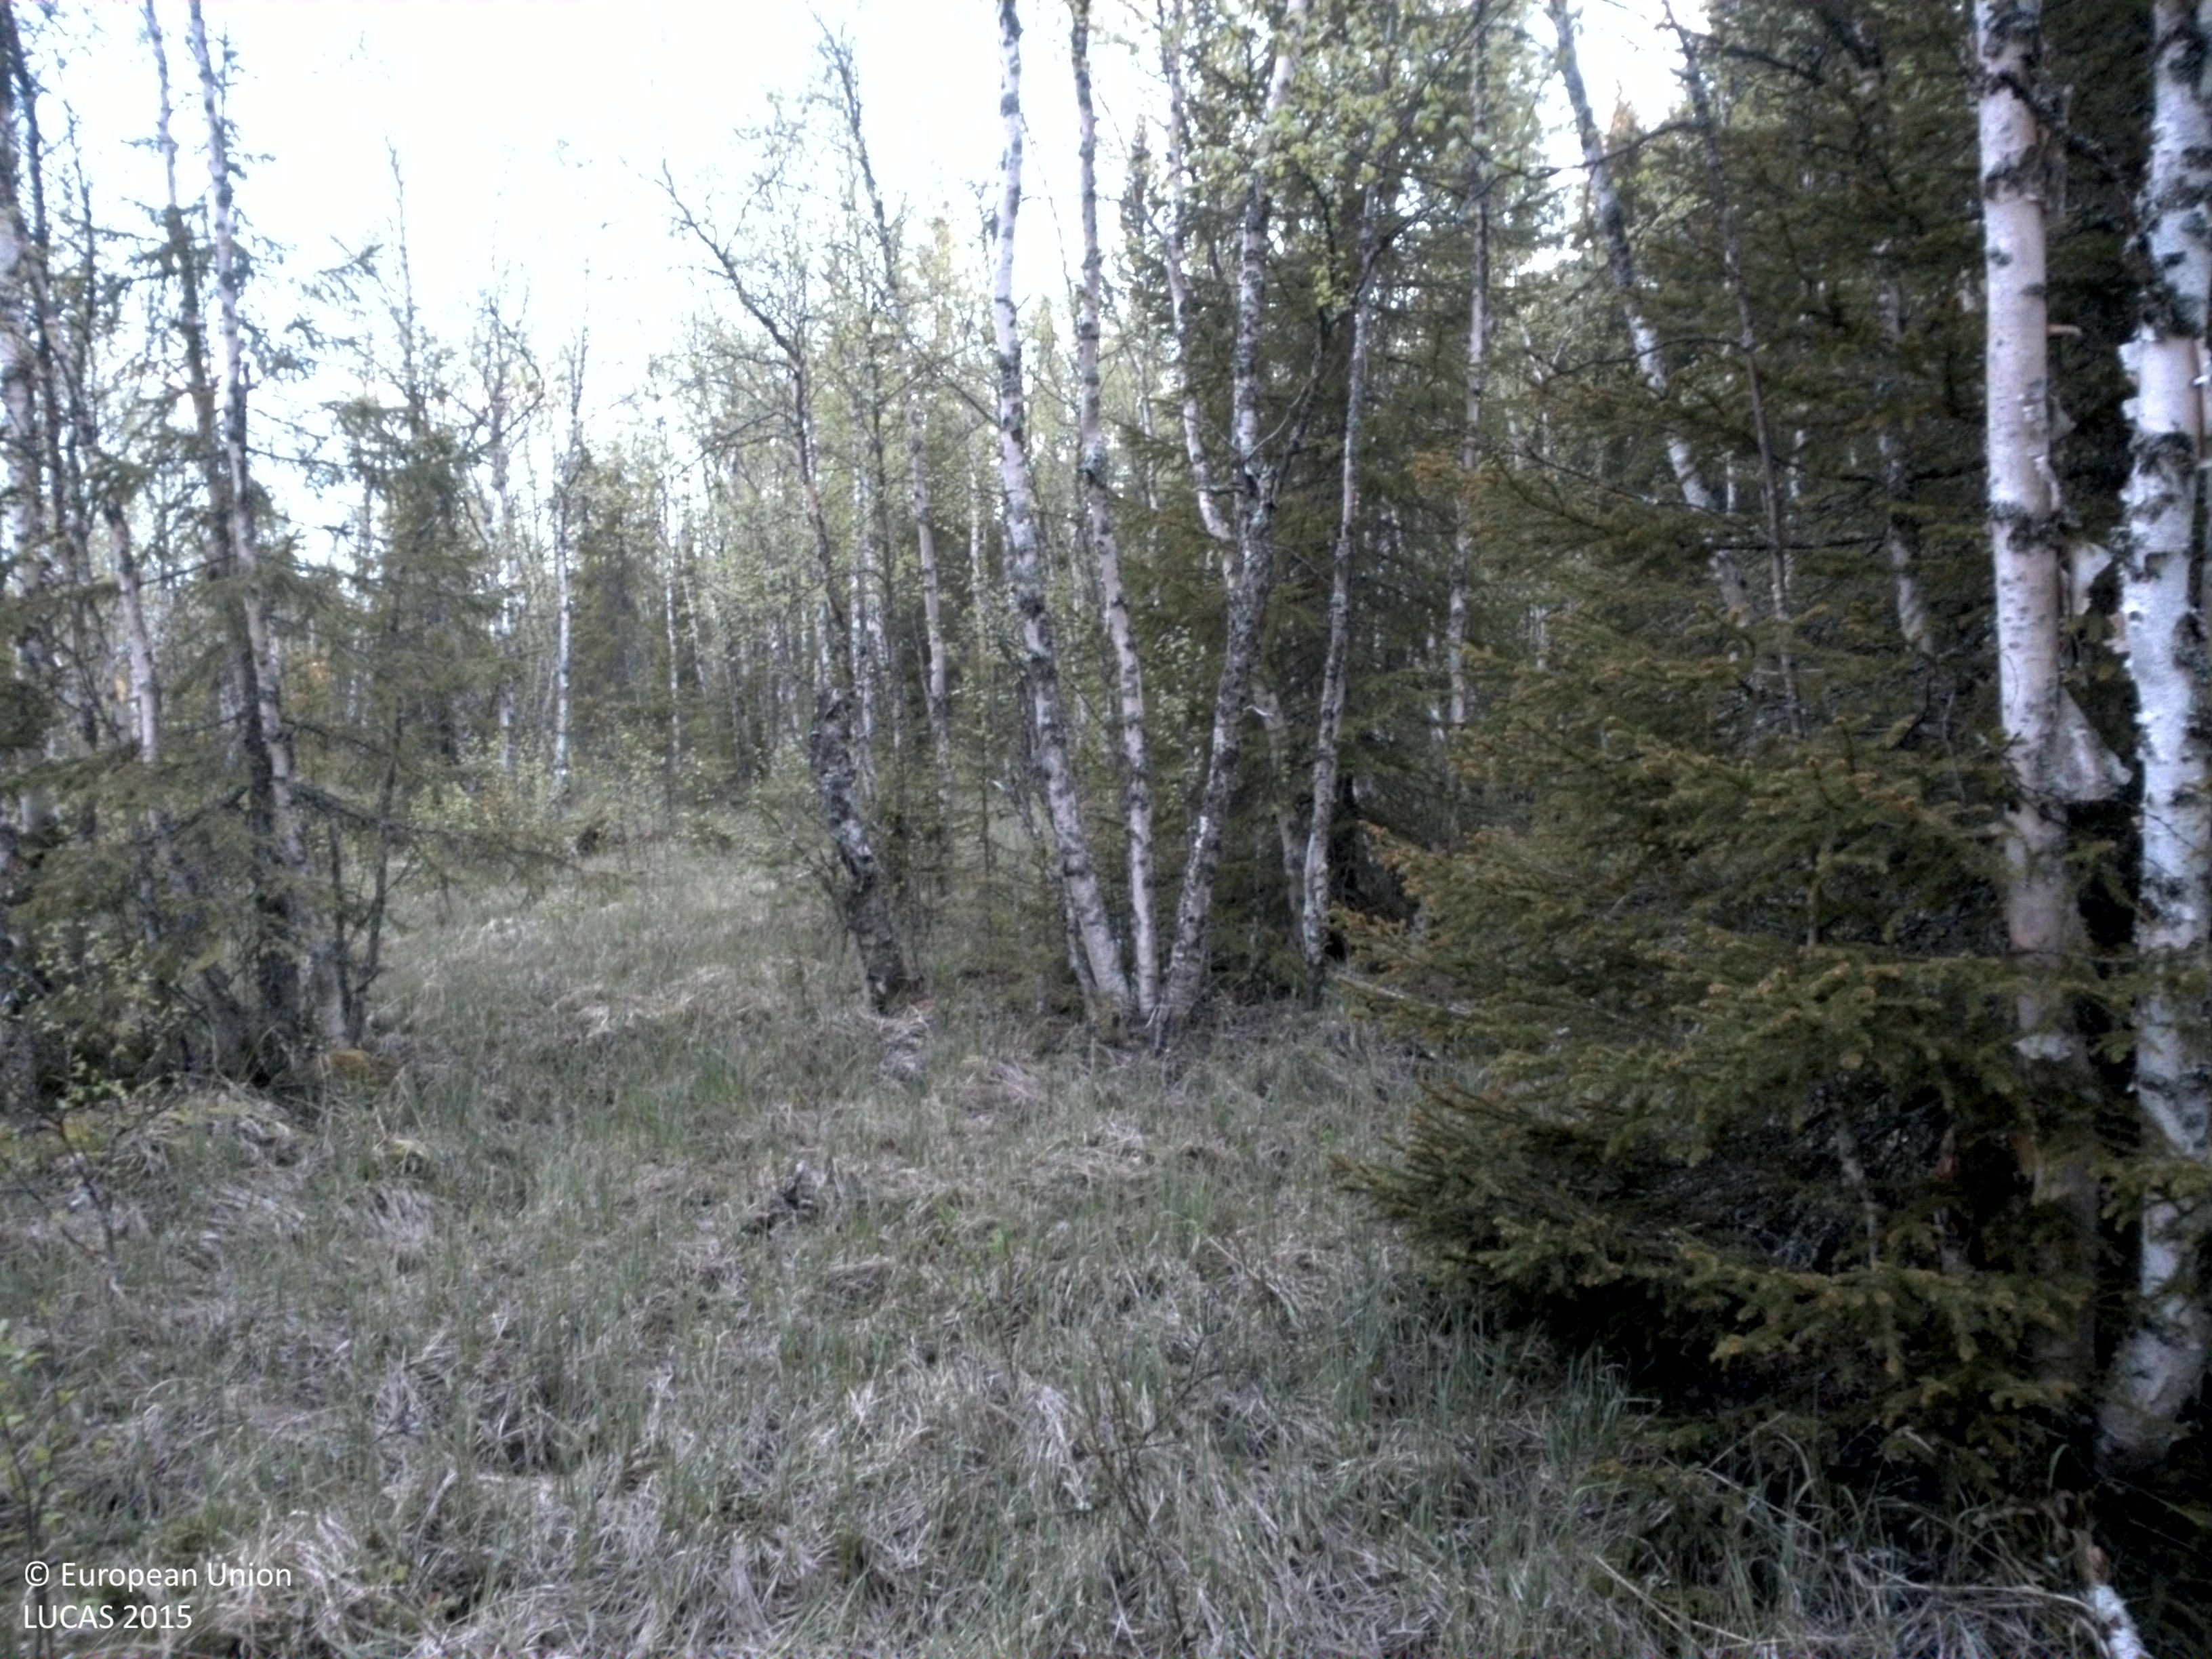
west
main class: Woodland
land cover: Spruce dominated mixed woodland
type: mire and swamp forests
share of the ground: 50 - 75 %
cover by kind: coniferous forest trees 30 %, broadleaved forest trees 25 %, herbaceous plants 20 %, shrubs 10 %, lichens and mosses 10 %
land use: Forestry
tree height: > 5 m
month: June
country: SE
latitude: 64.1994
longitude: 17.5680
